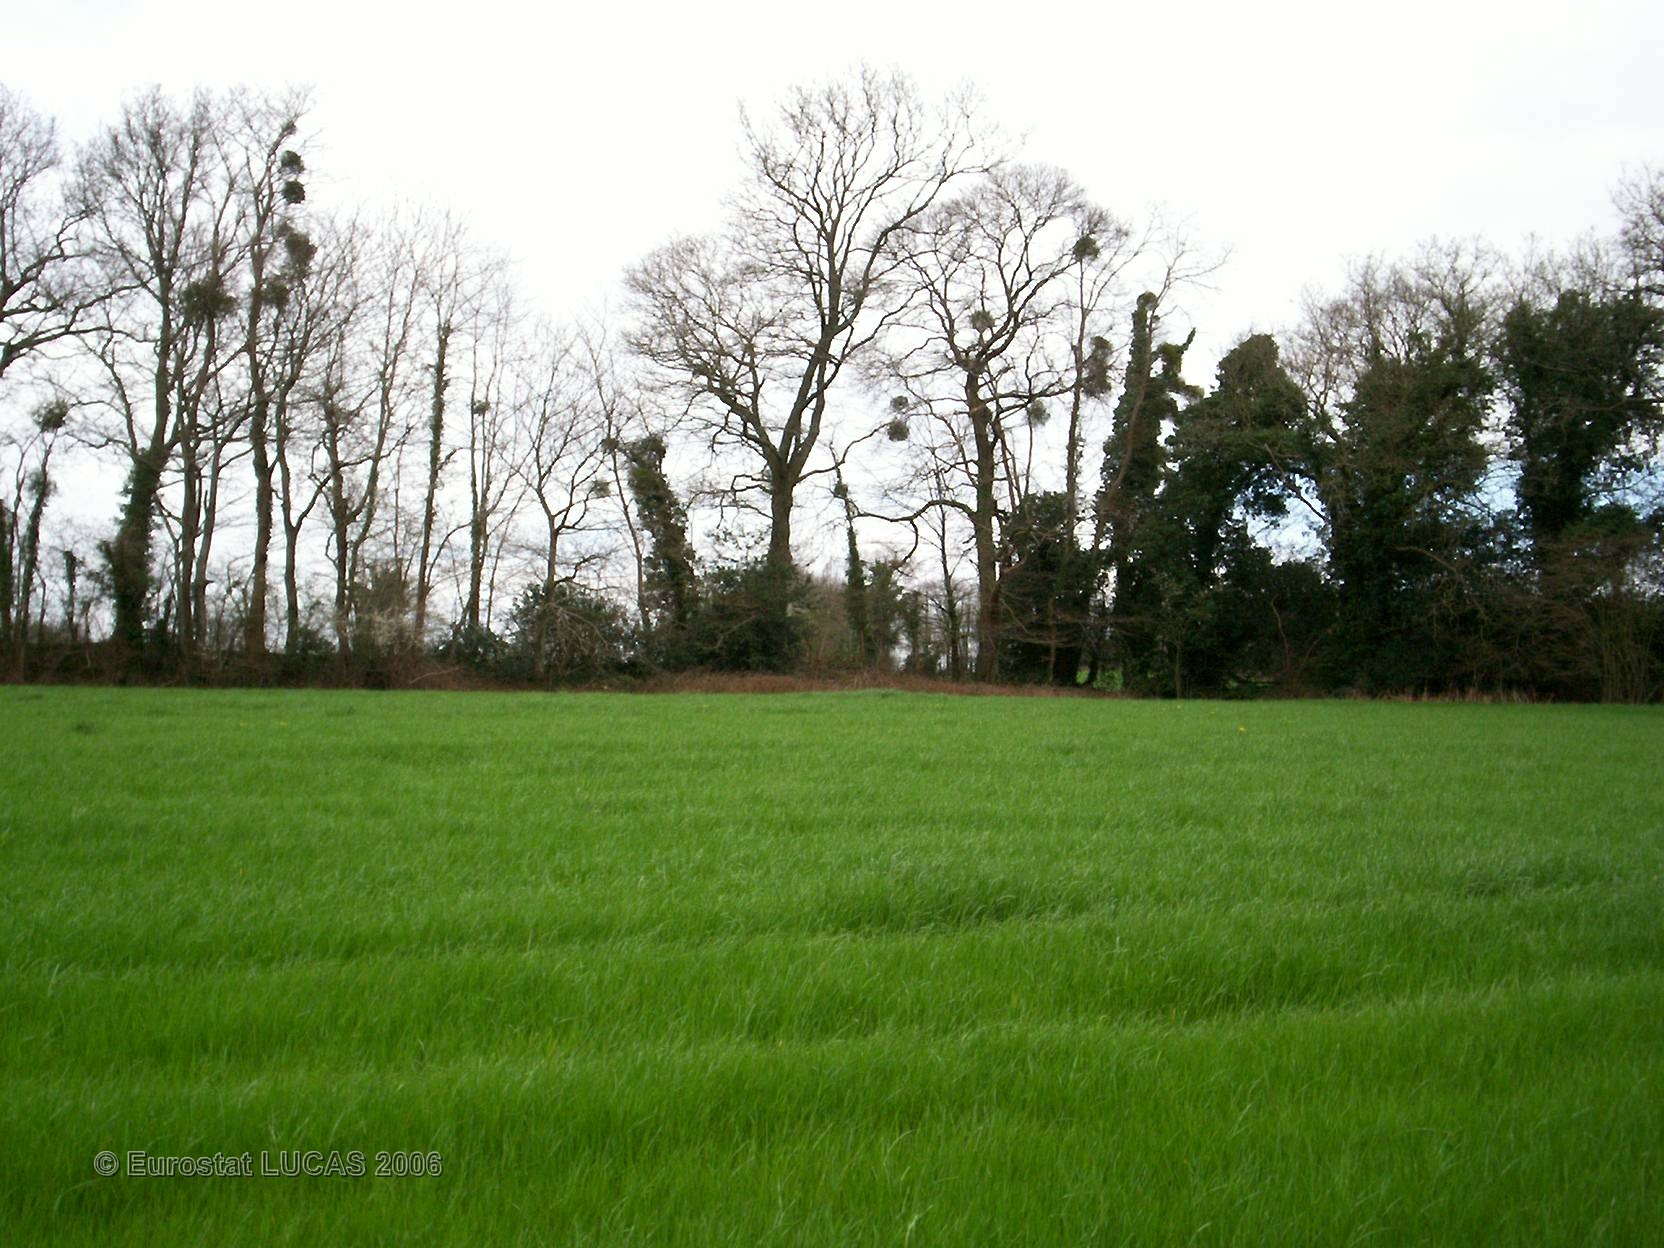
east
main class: Grassland
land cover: Grassland without tree/shrub cover
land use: Agriculture (excluding fallow land and kitchen gardens)
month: April
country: FR
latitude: 47.9321
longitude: -3.5288
